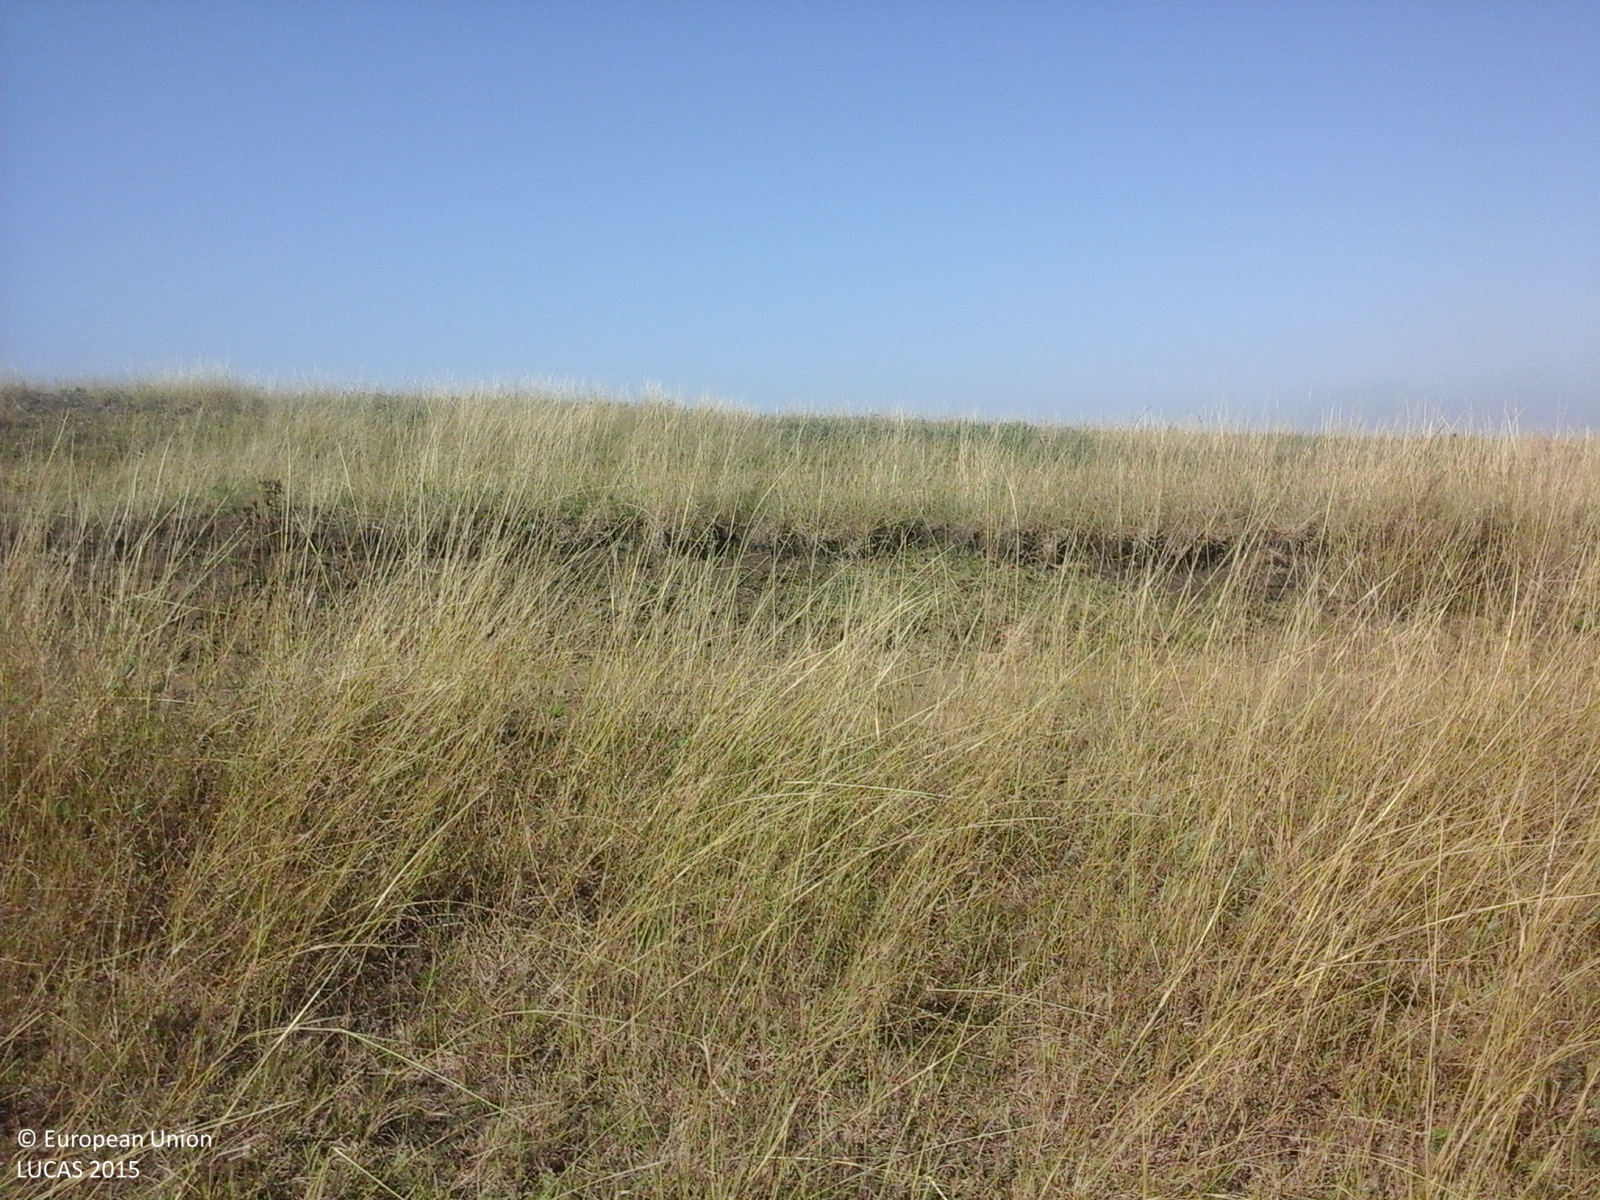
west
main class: Grassland
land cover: Grassland without tree/shrub cover
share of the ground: > 75 %
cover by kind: herbaceous plants 100 %
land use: Agriculture (excluding fallow land and kitchen gardens)
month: October
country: RO
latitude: 46.1346
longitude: 23.8833
